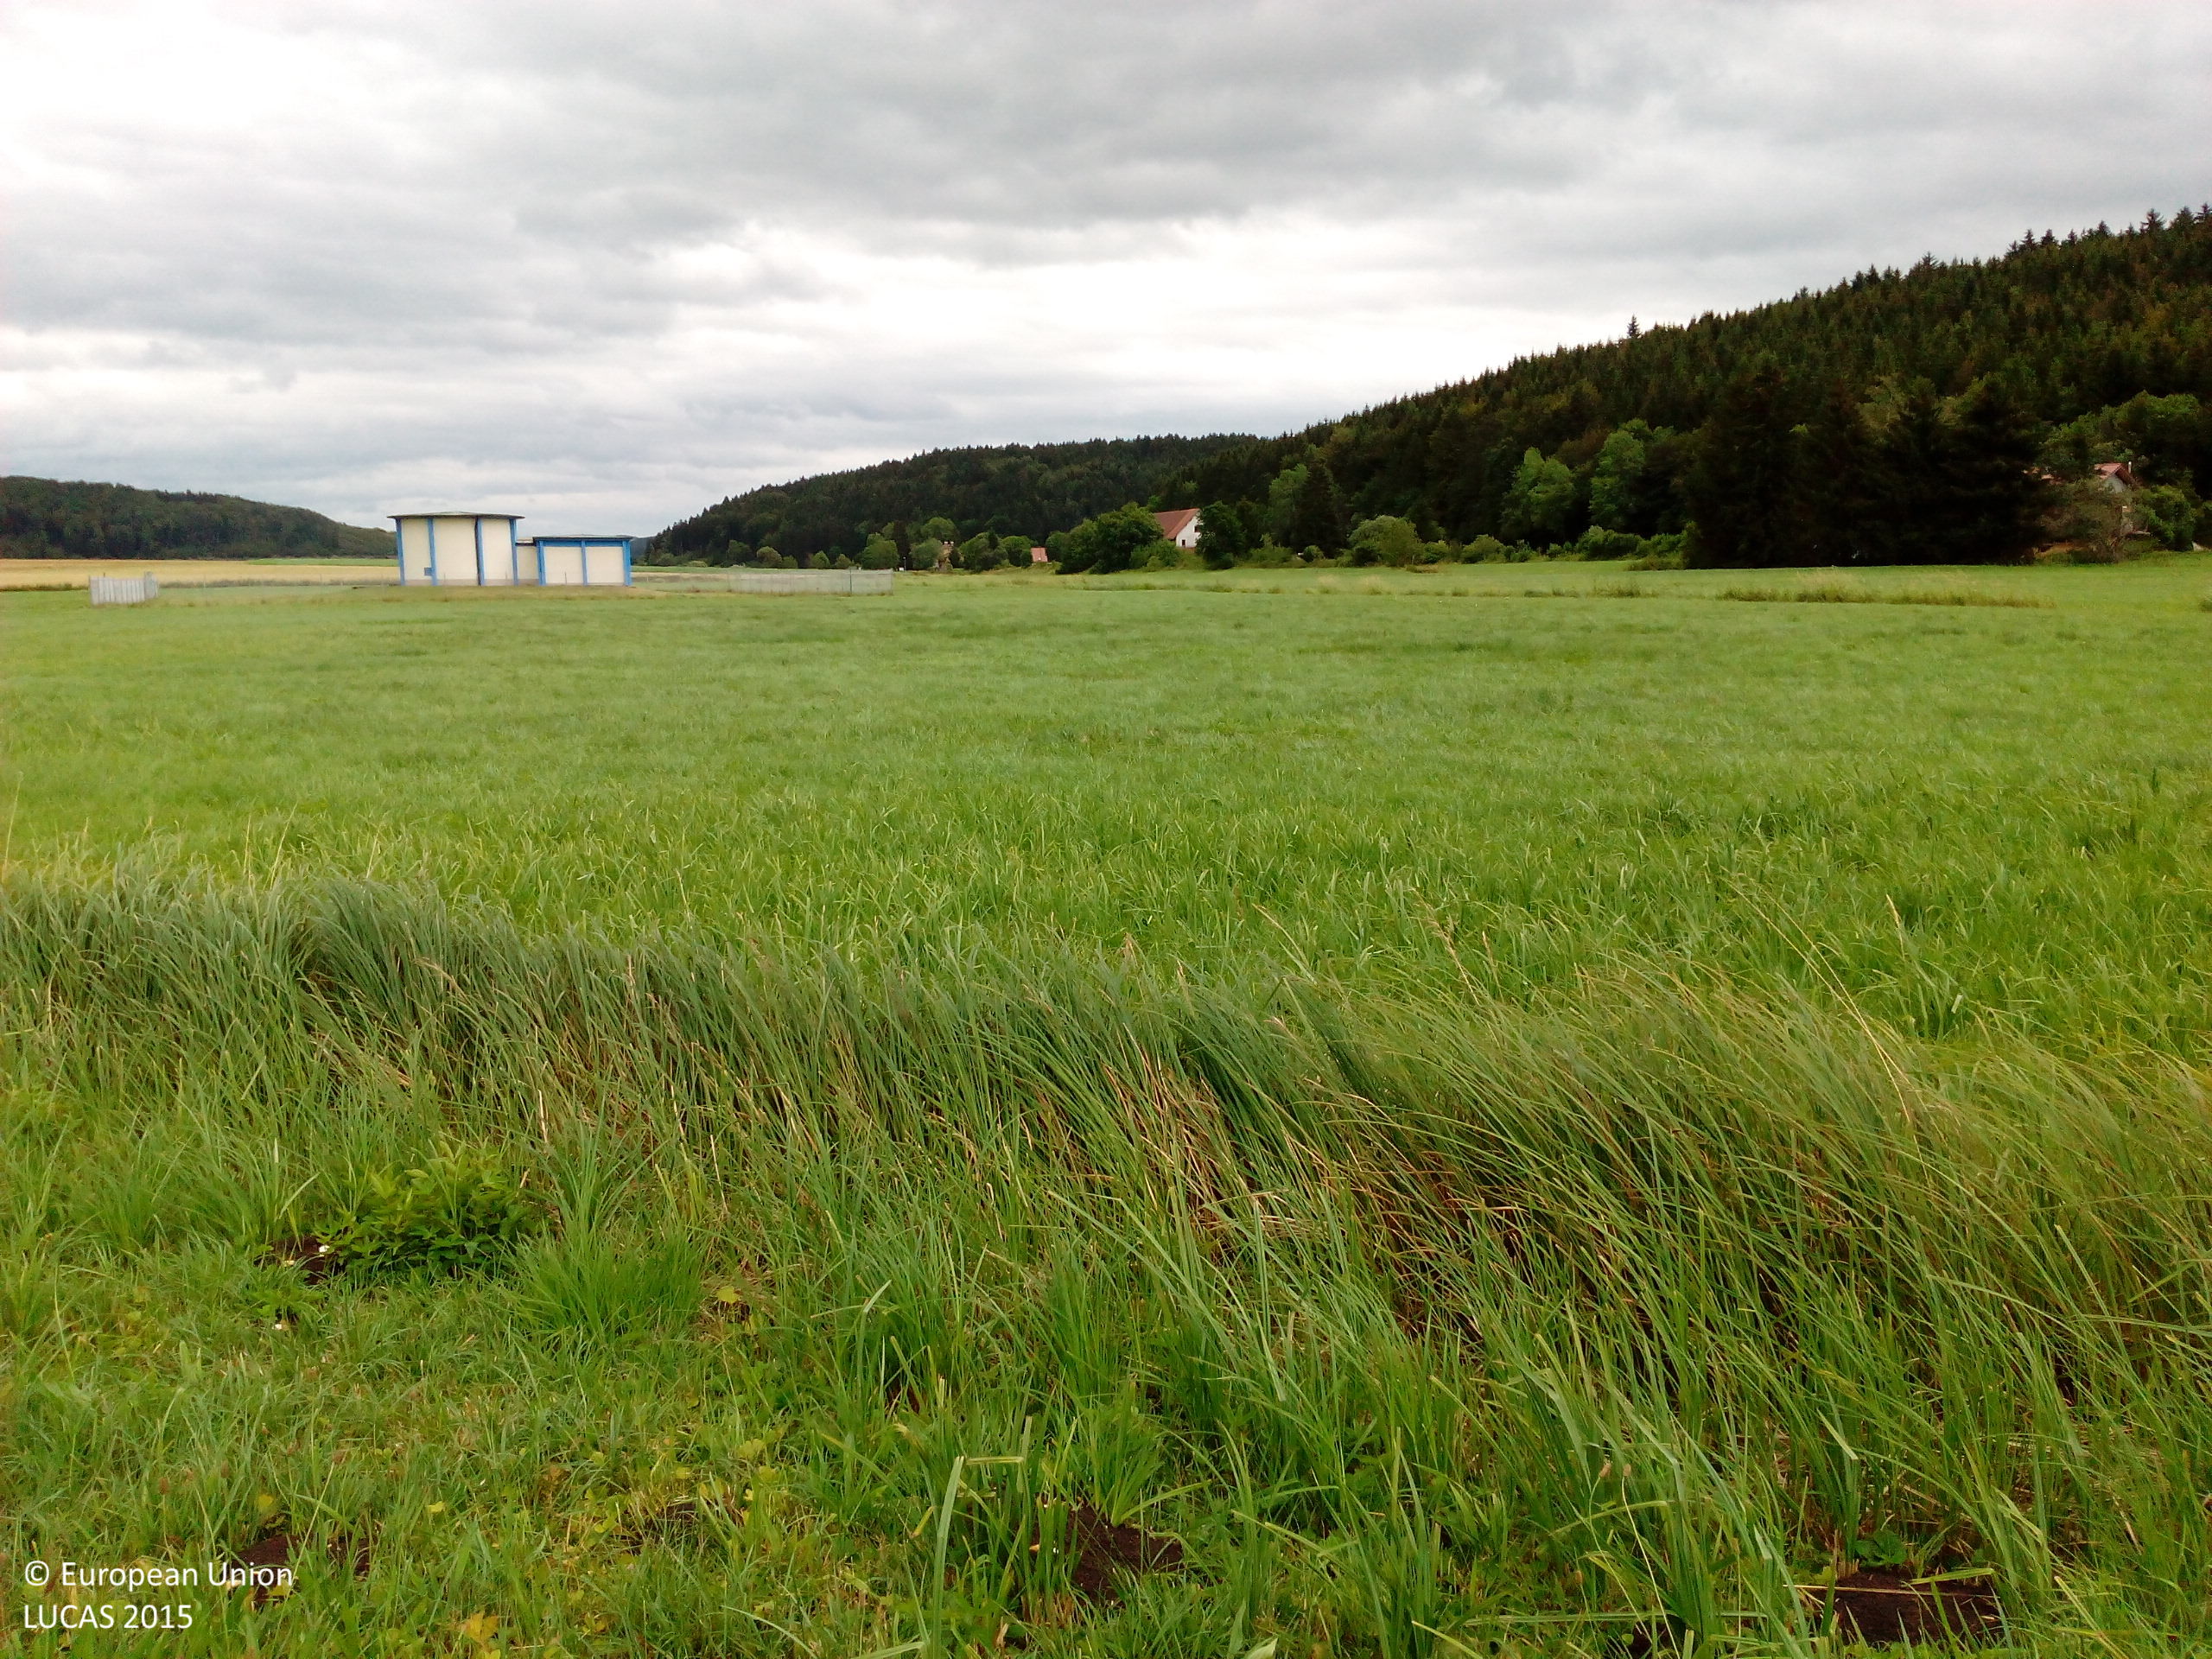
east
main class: Grassland
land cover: Grassland without tree/shrub cover
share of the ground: > 75 %
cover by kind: herbaceous plants 95 %, unconsolidated bare surface 5 %
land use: Agriculture (excluding fallow land and kitchen gardens)
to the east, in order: Grassland without tree/shrub cover; Ditches and canals; Grassland without tree/shrub cover; Rivers and streams; Shruby margins; Grassland without tree/shrub cover
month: July
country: DE
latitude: 47.8546
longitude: 8.5976
